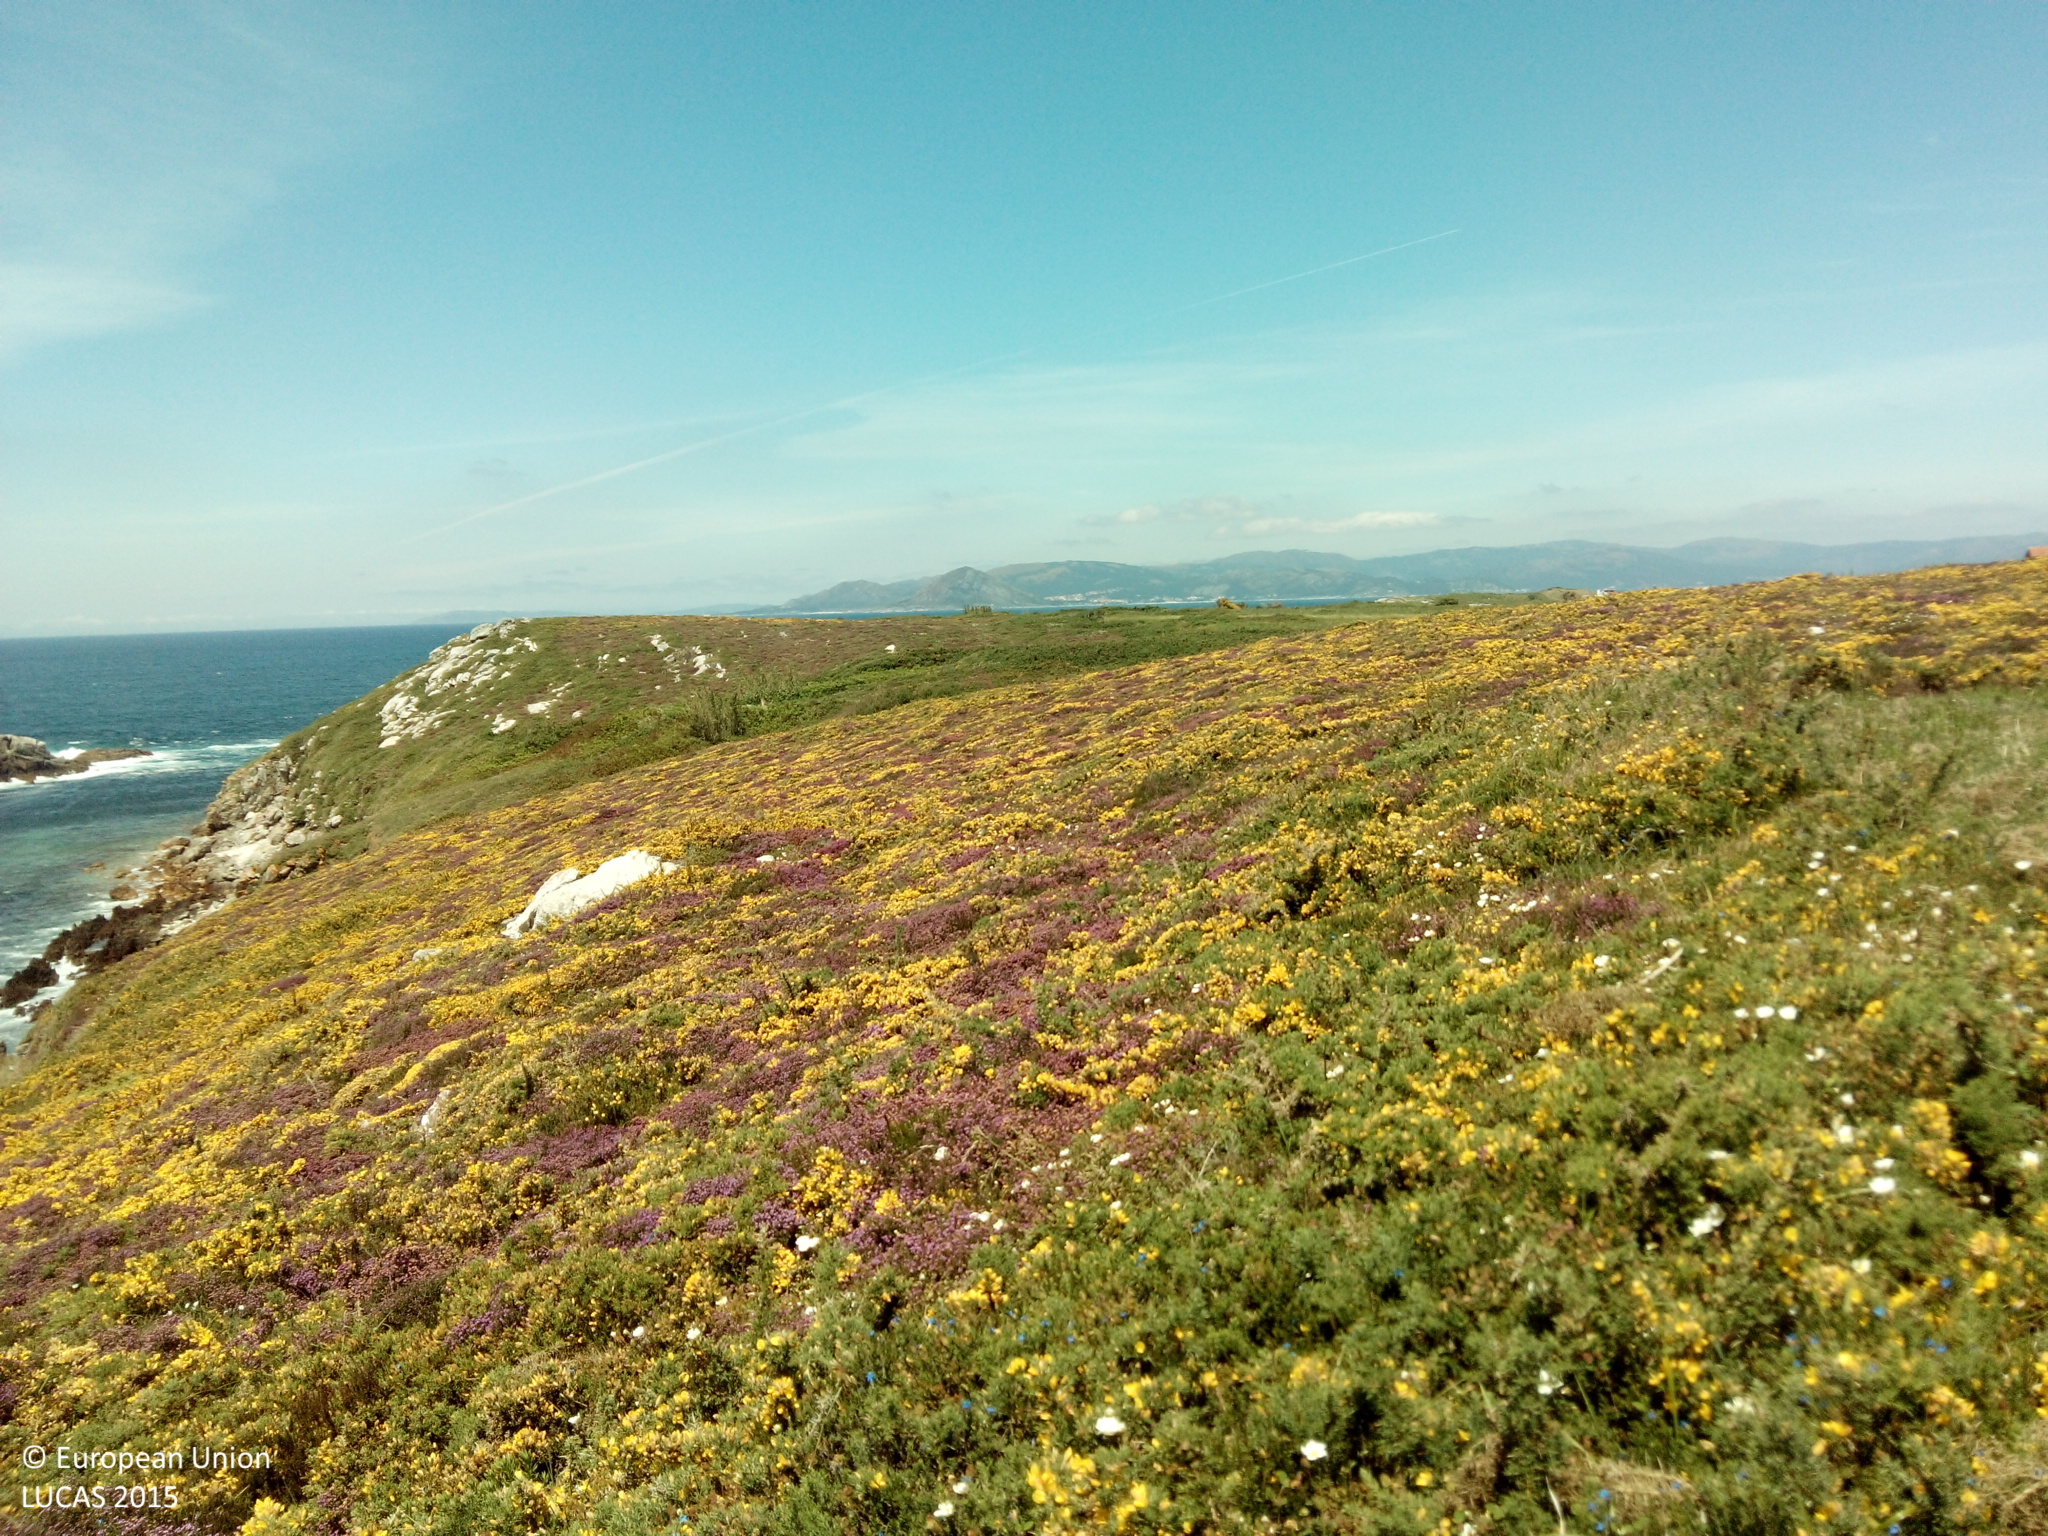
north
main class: Shrubland
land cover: Shrubland without tree cover
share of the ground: > 75 %
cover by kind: shrubs 100 %
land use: Semi-natural and natural areas not in use
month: May
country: ES
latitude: 42.6599
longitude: -9.0393
